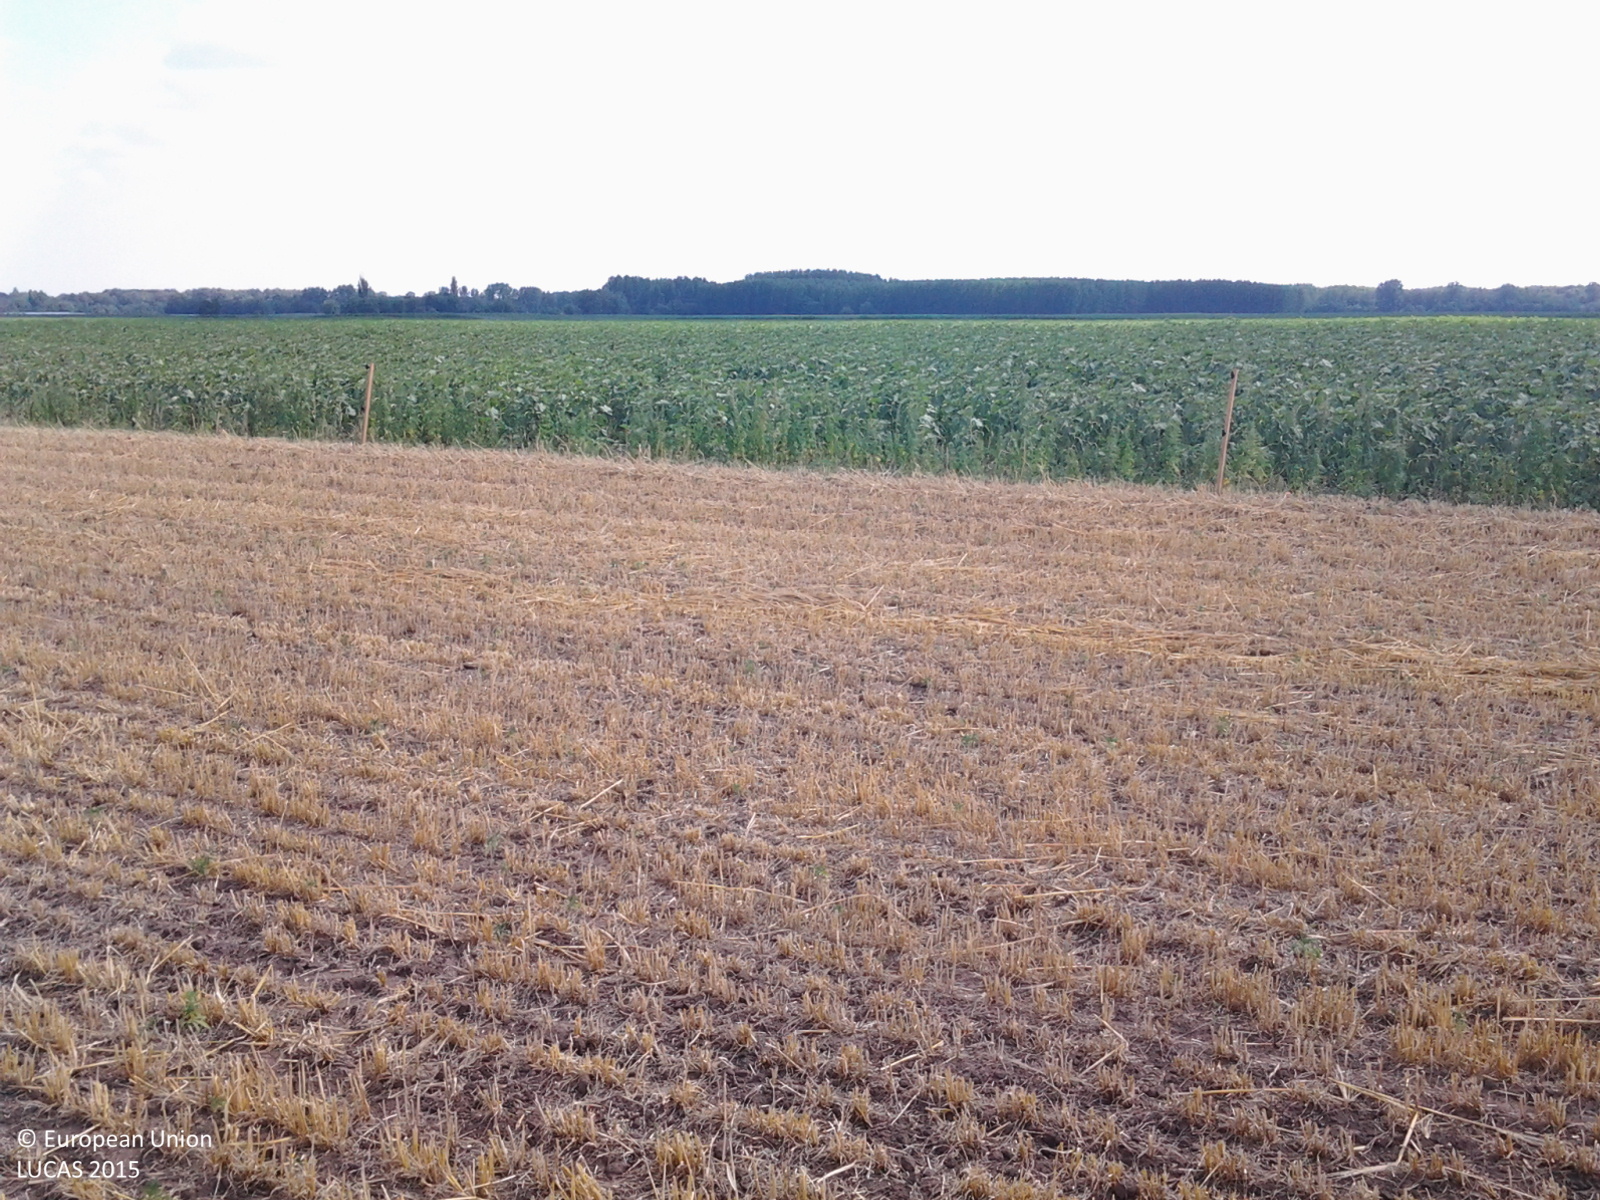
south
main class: Cropland
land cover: Barley
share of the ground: > 75 %
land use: Agriculture (excluding fallow land and kitchen gardens)
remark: Harvested field
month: July
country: HU
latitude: 47.4952
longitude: 19.8071
